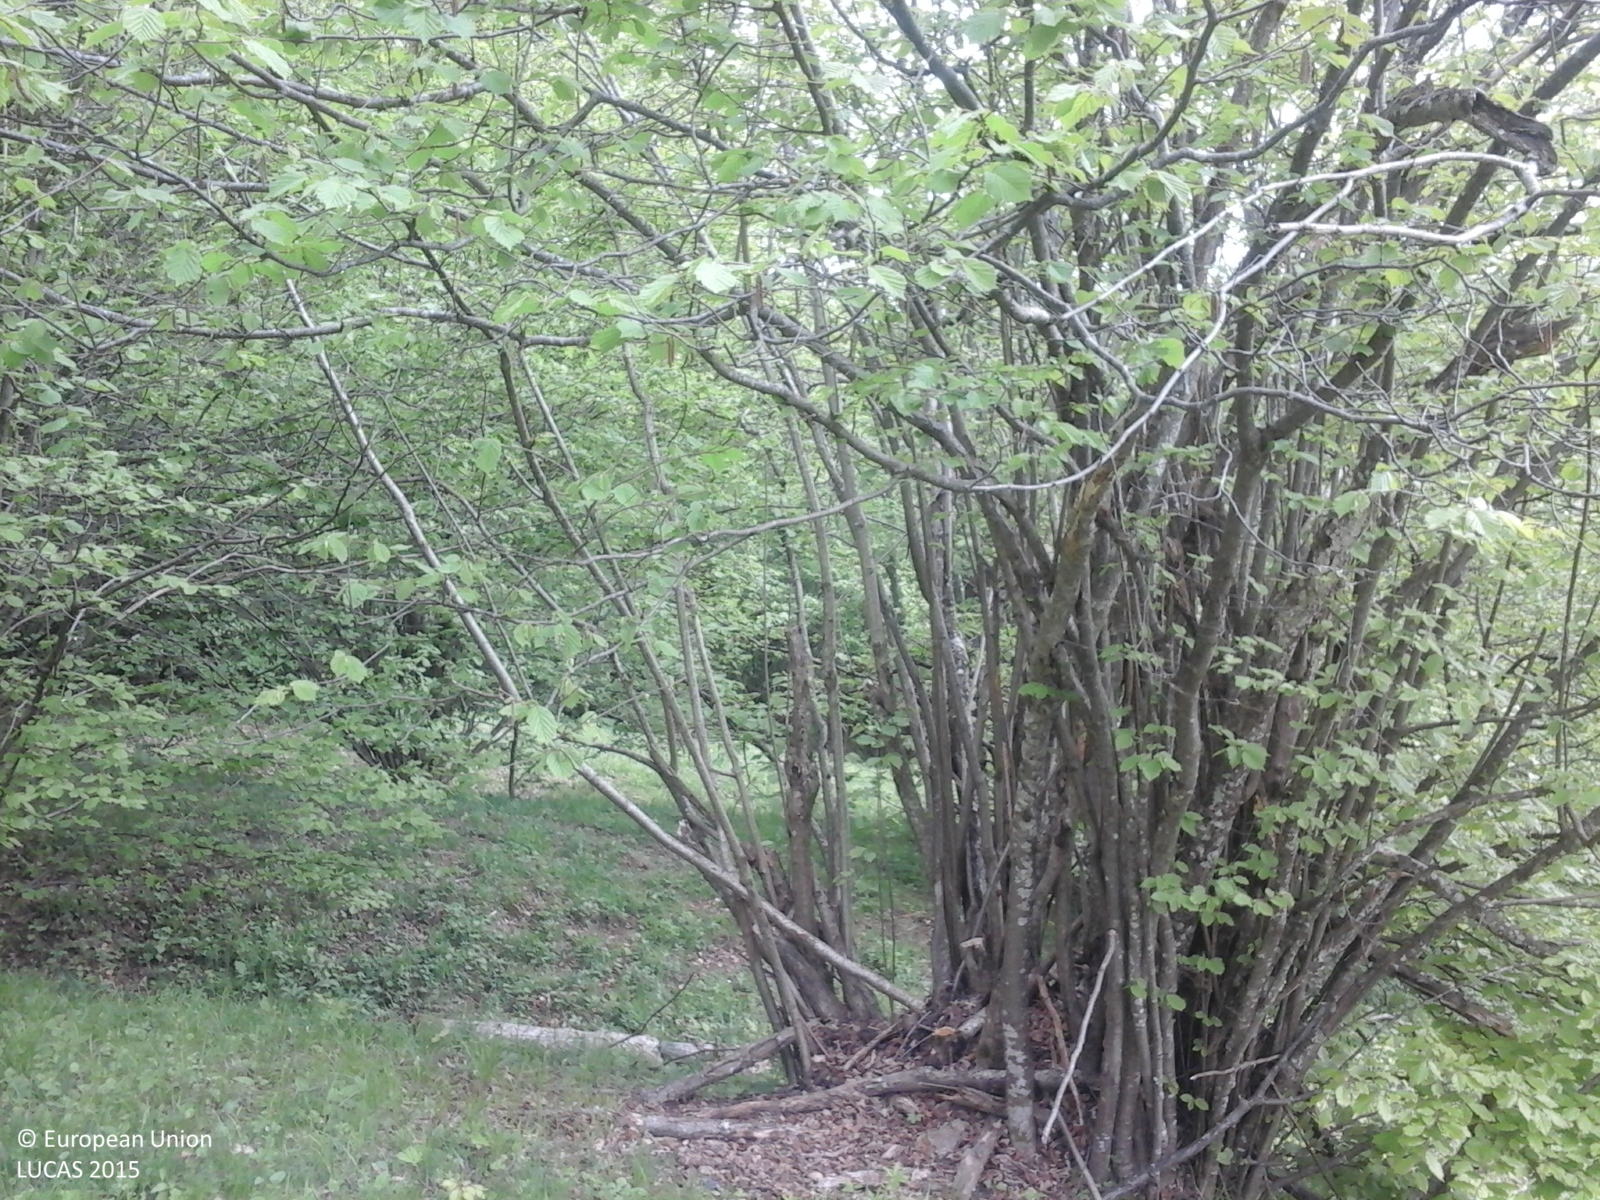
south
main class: Grassland
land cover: Grassland without tree/shrub cover
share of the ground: > 75 %
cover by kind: herbaceous plants 100 %
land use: Agriculture (excluding fallow land and kitchen gardens)
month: May
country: RO
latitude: 45.6037
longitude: 25.9466
